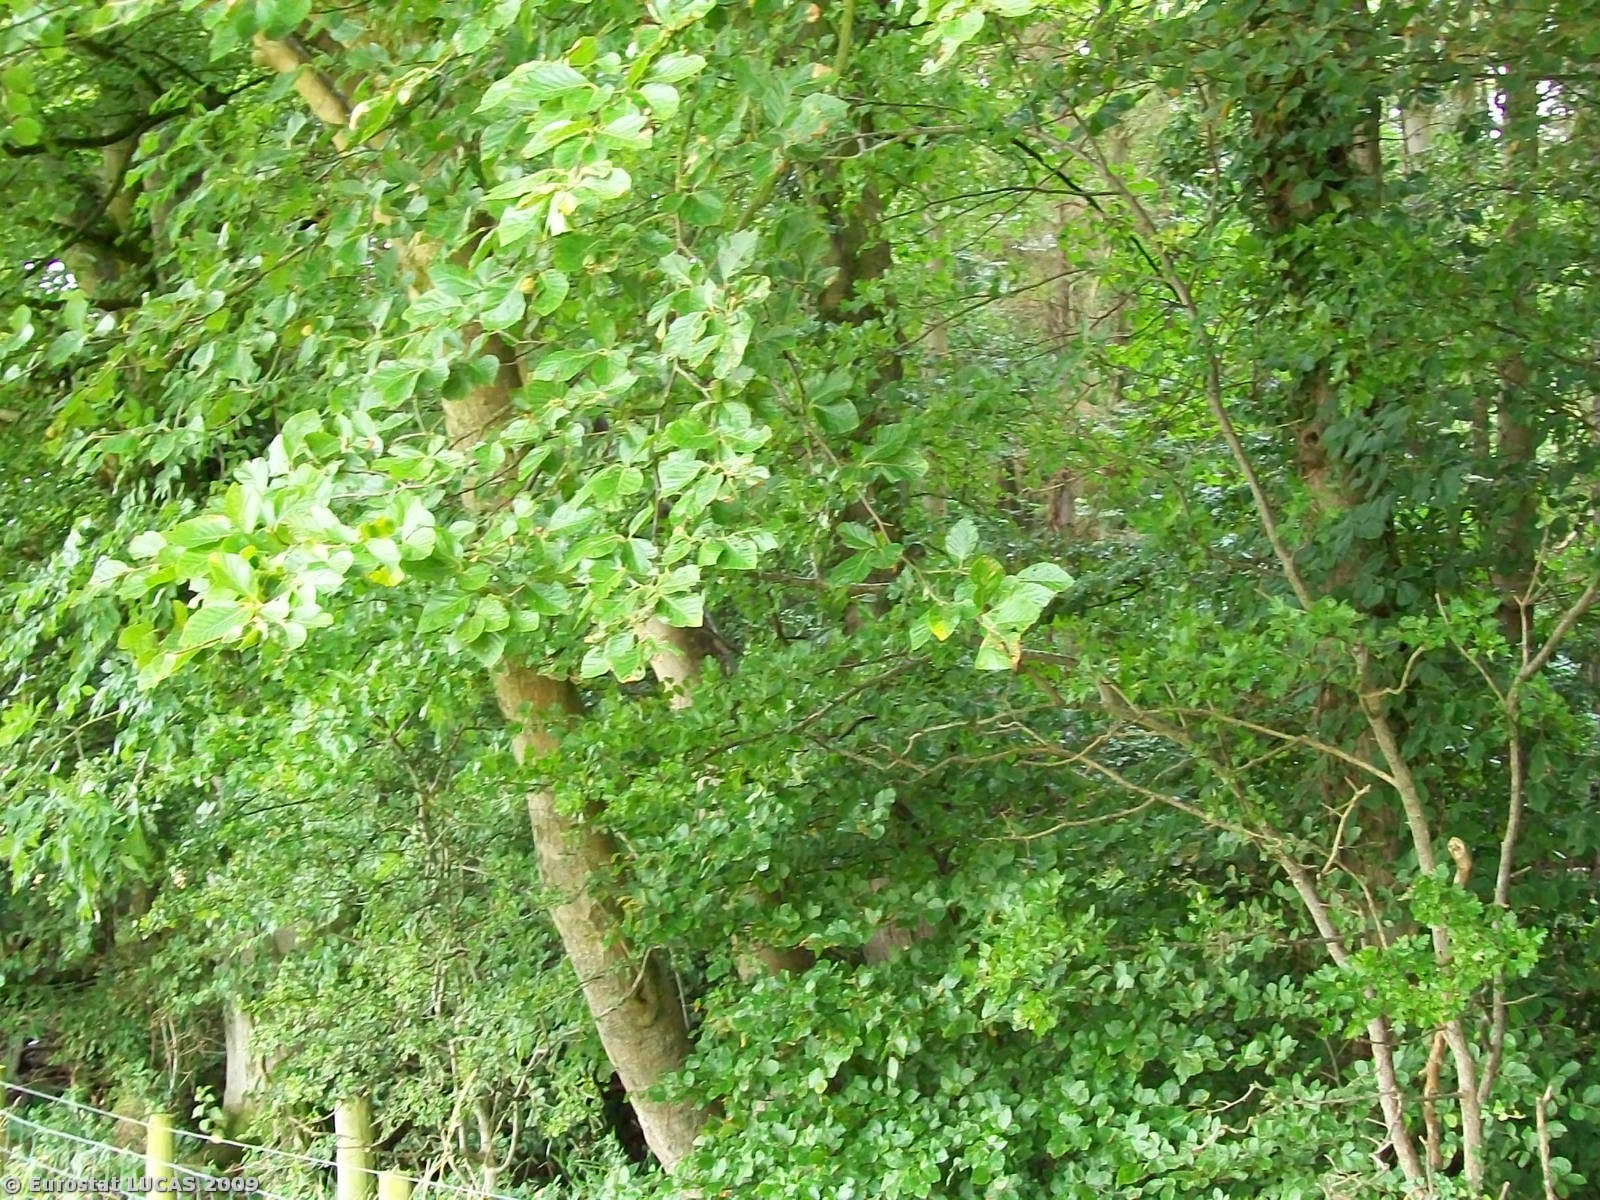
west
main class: Grassland
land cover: Grassland without tree/shrub cover
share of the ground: > 75 %
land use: Agriculture (excluding fallow land and kitchen gardens)
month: July
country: GB
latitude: 55.0034
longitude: -3.2556
